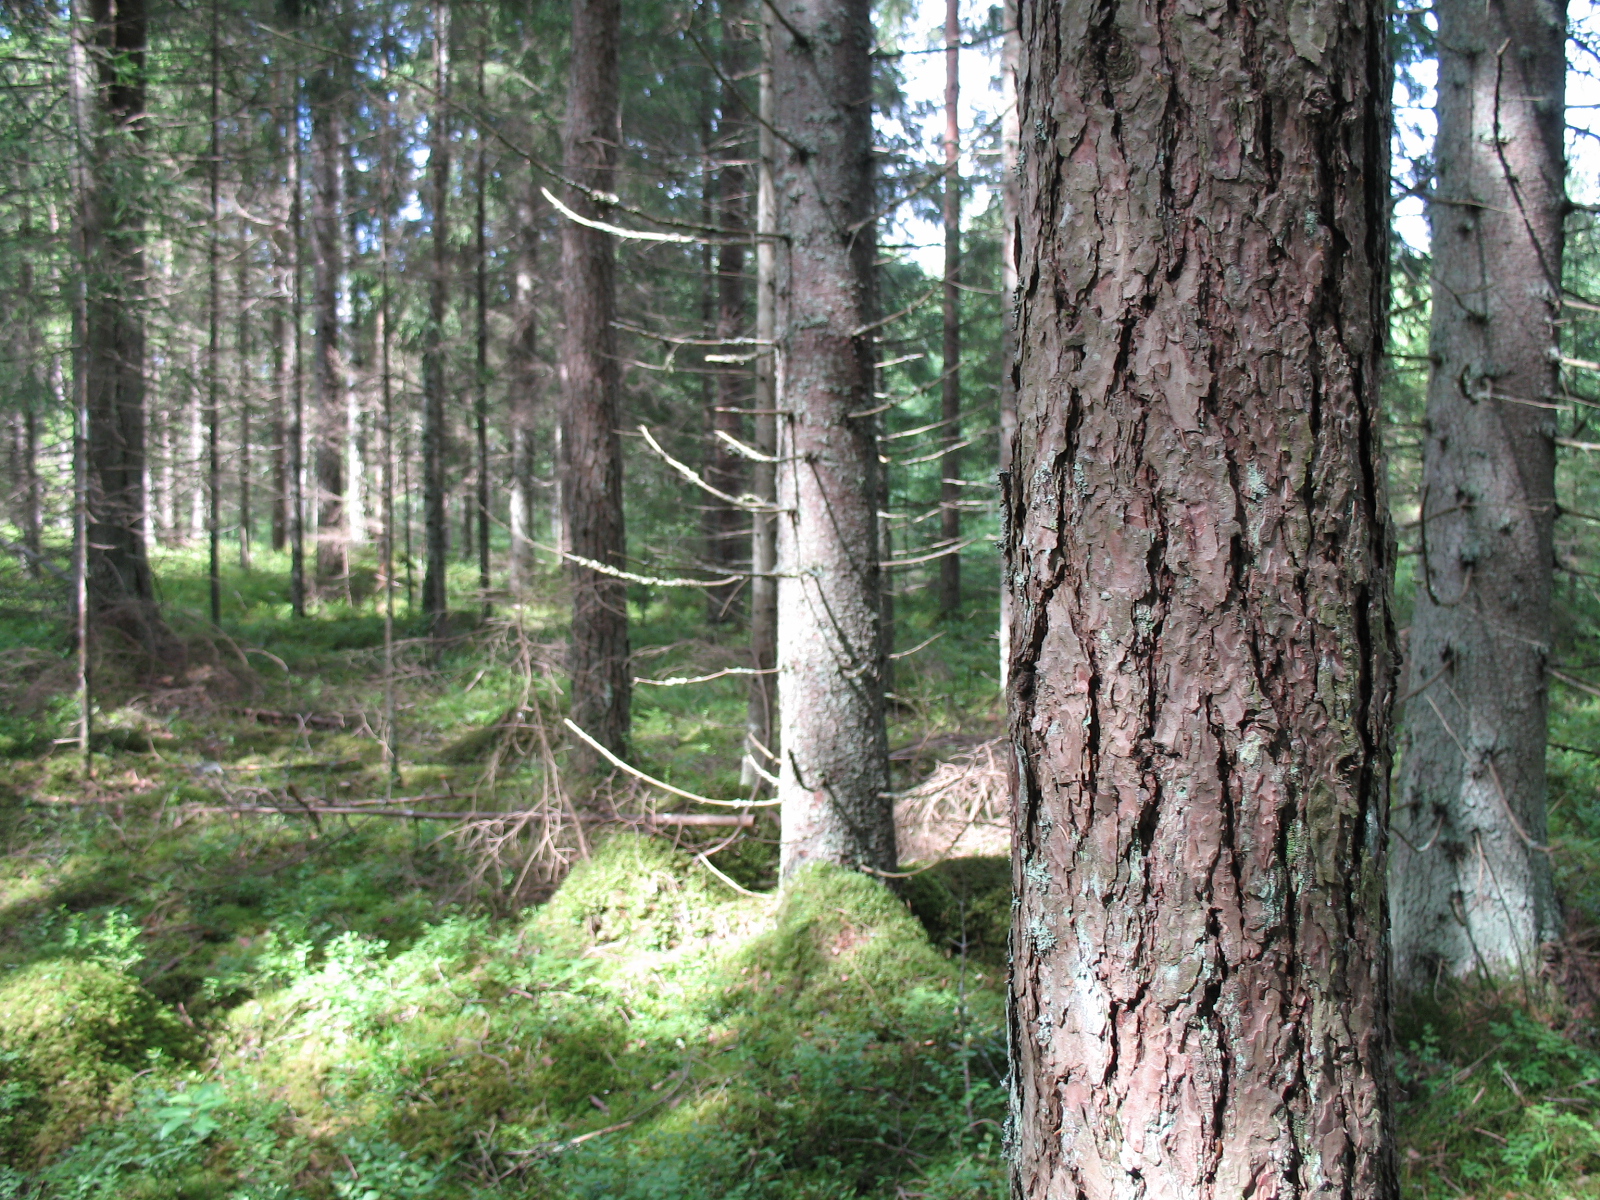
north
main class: Woodland
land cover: Other coniferous woodland
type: hemiboreal forest and nemoral coniferous forest and mixed broadleaved-coniferous forest
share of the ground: > 75 %
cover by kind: coniferous forest trees 85 %, lichens and mosses 10 %, herbaceous plants 5 %
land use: Forestry
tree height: > 5 m
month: July
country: LV
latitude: 56.5451
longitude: 25.1561
